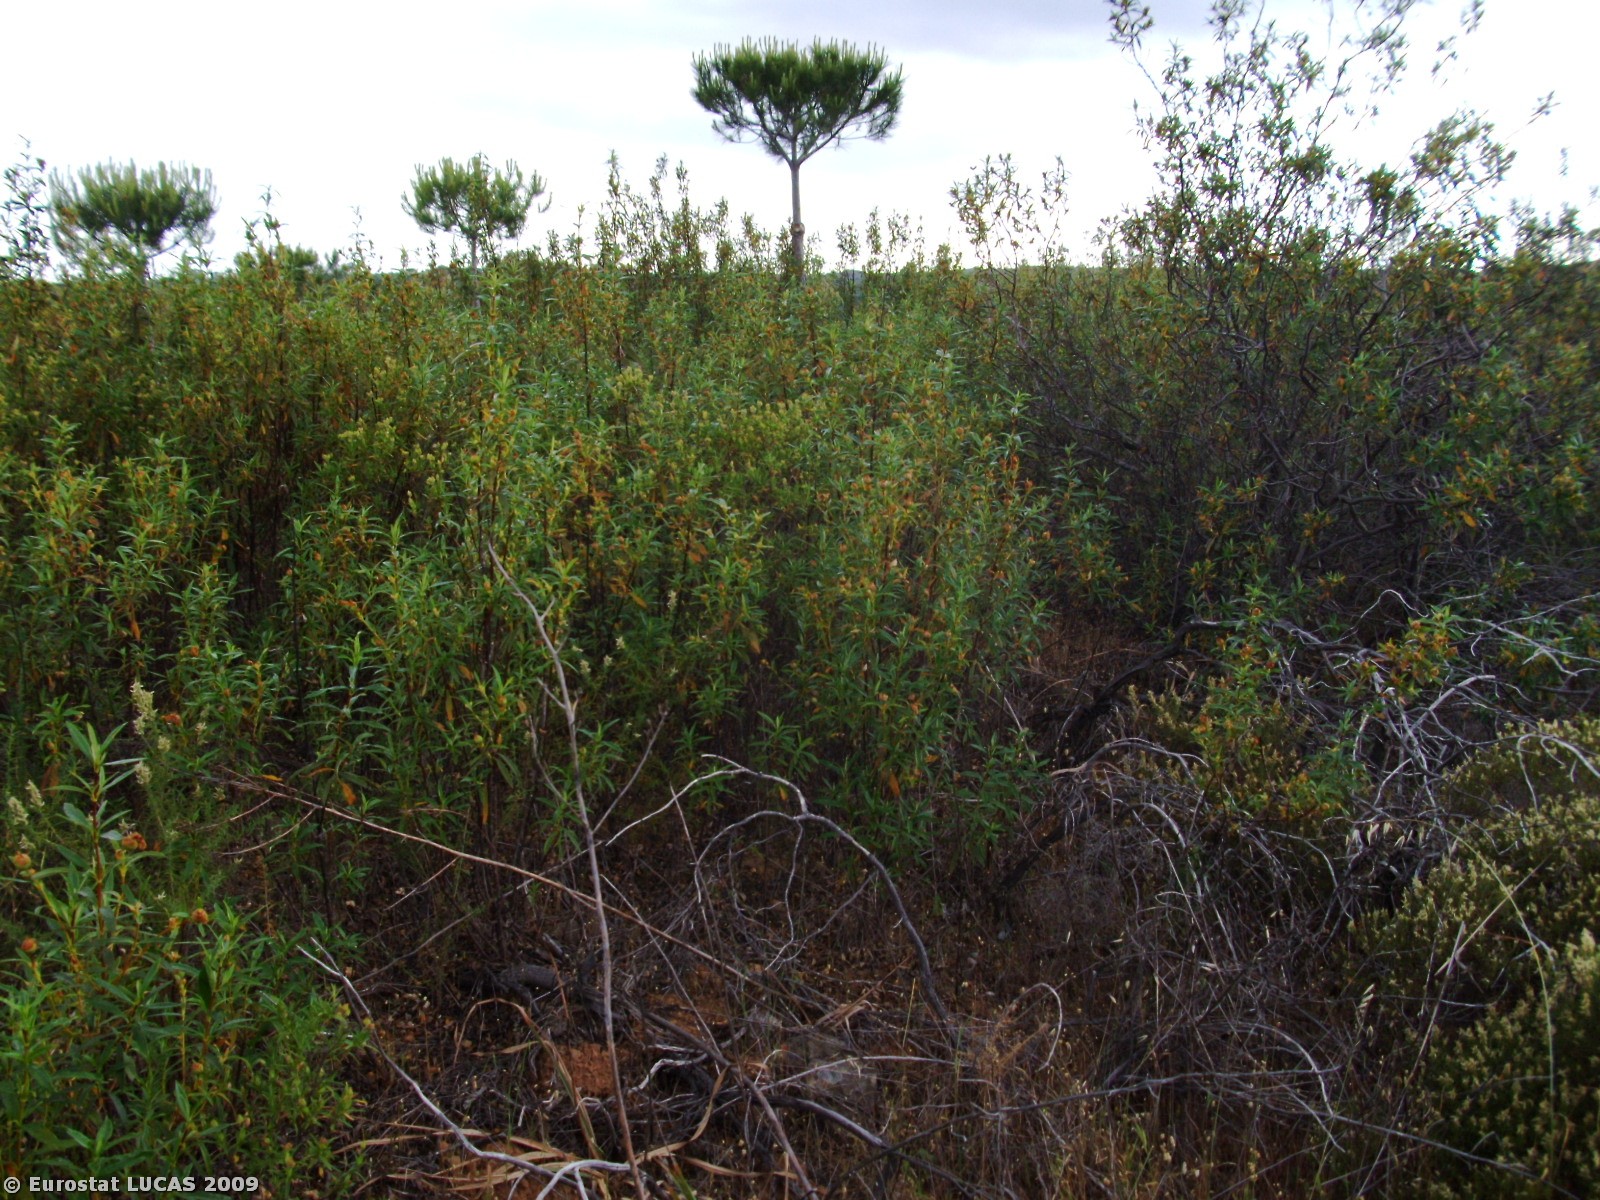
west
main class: Shrubland
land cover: Shrubland without tree cover
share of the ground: > 75 %
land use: Unused
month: April
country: PT
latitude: 37.2987
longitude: -7.4794
